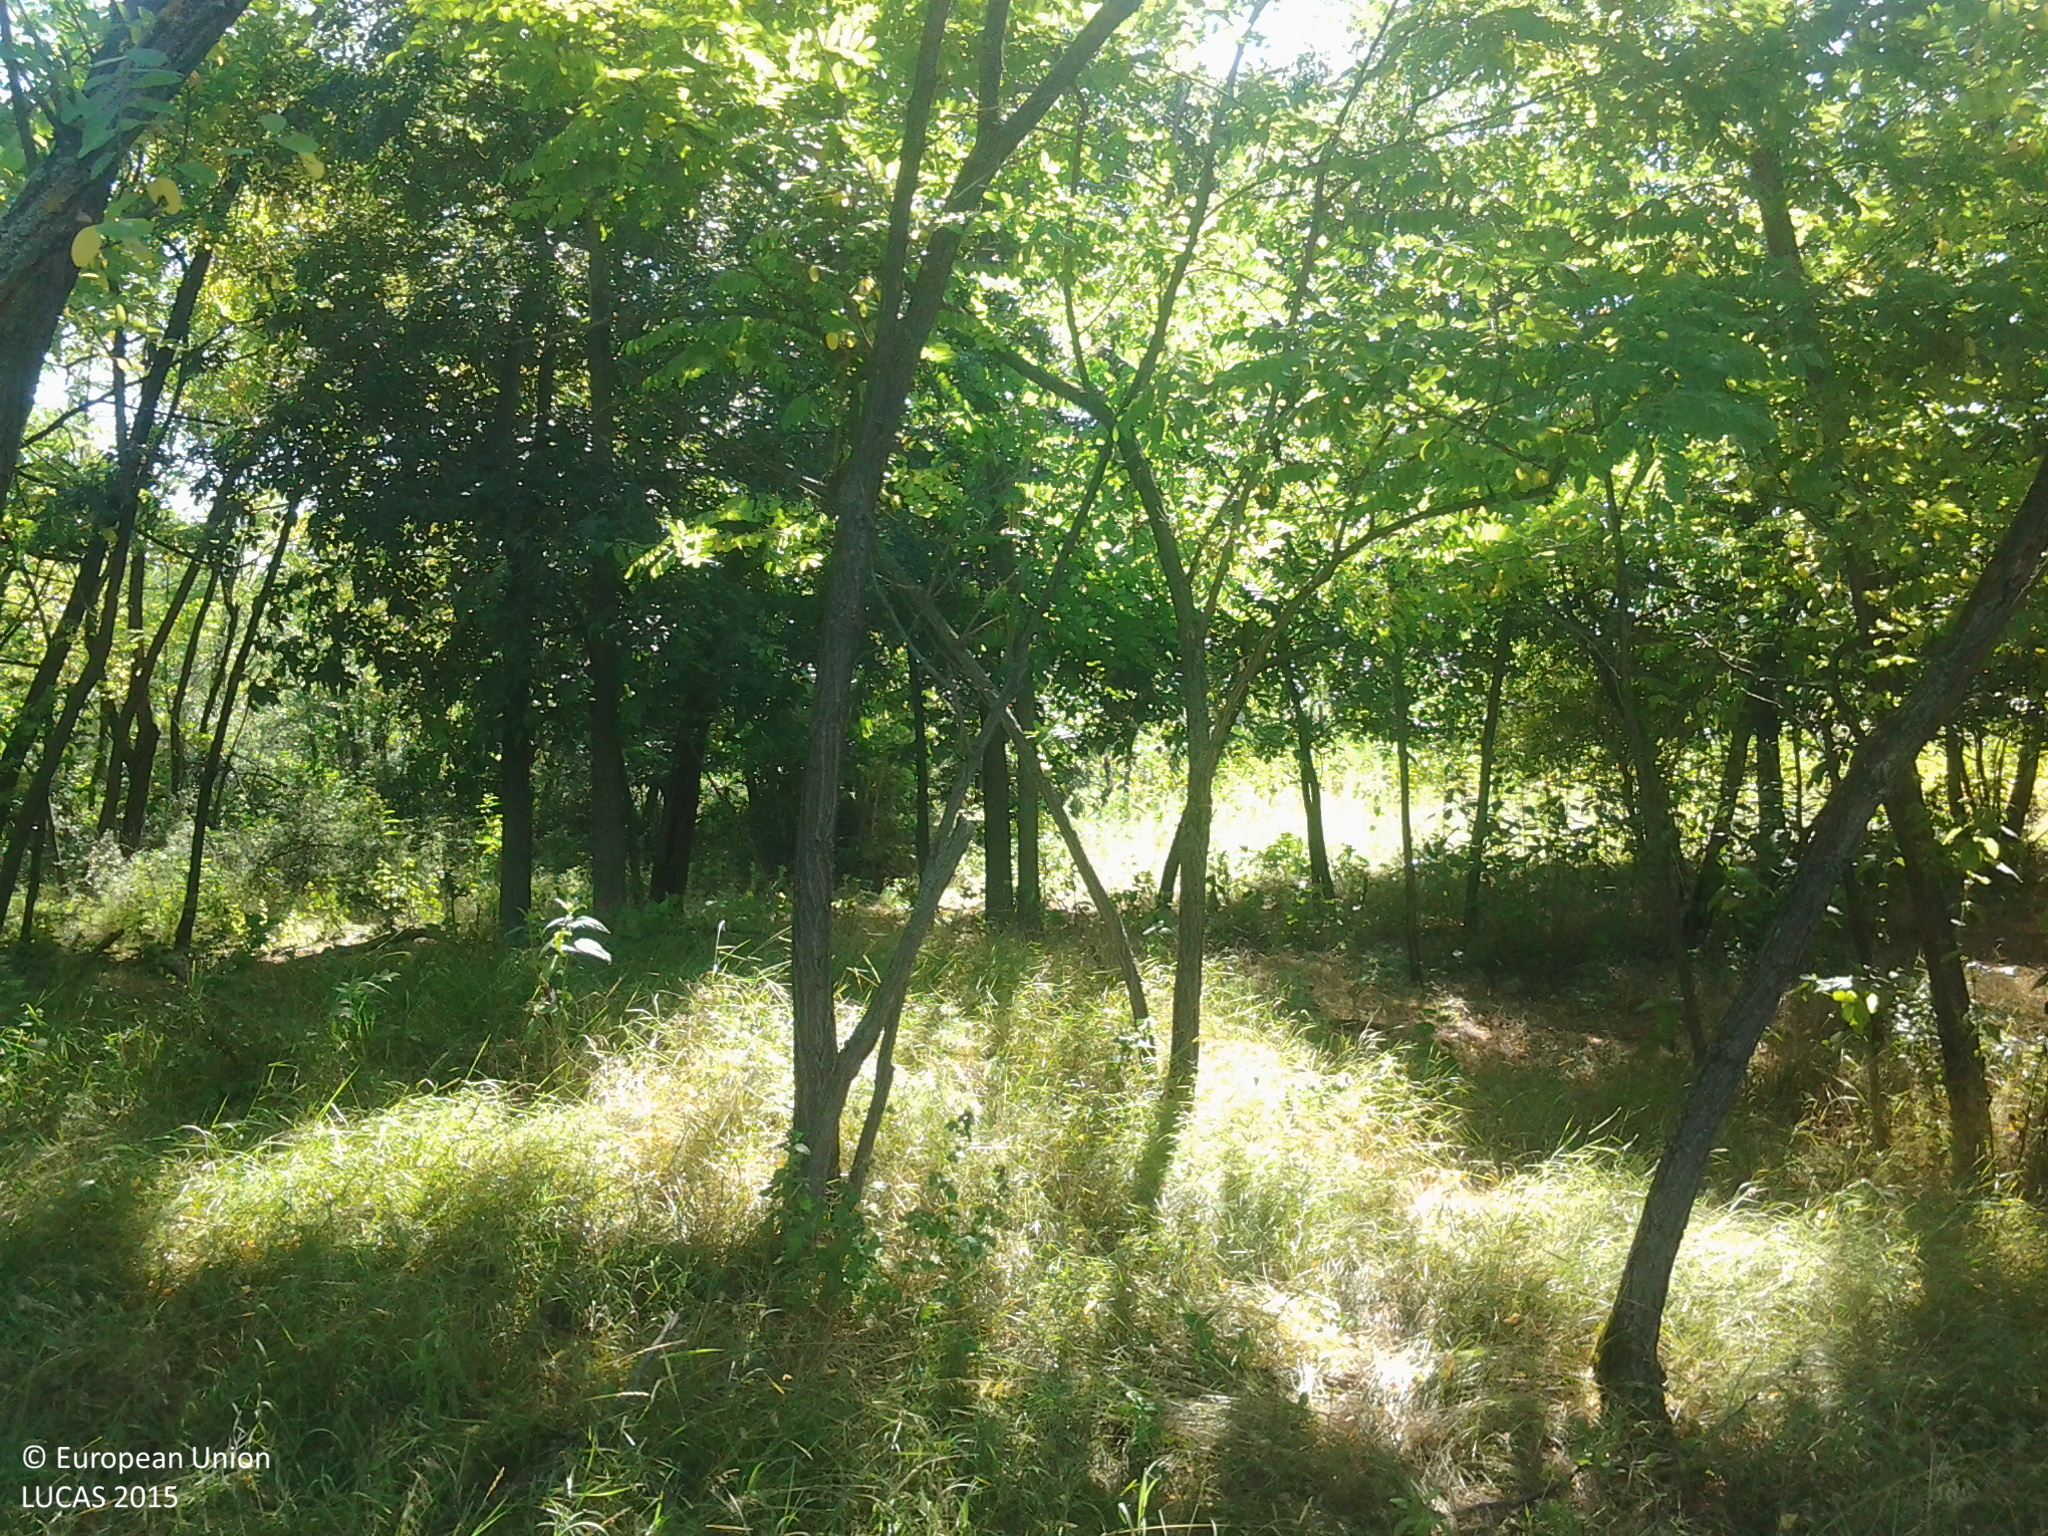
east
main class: Woodland
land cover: Broadleaved woodland
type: exotic forest
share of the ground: 50 - 75 %
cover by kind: broadleaved forest trees 70 %, herbaceous plants 30 %
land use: Forestry
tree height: > 5 m
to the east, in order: Broadleaved woodland; Grassland without tree/shrub cover; Broadleaved woodland; Spontaneously vegetated surfaces; Shrubland with sparse tree cover; Spontaneously vegetated surfaces
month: July
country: HU
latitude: 46.5395
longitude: 19.5500
